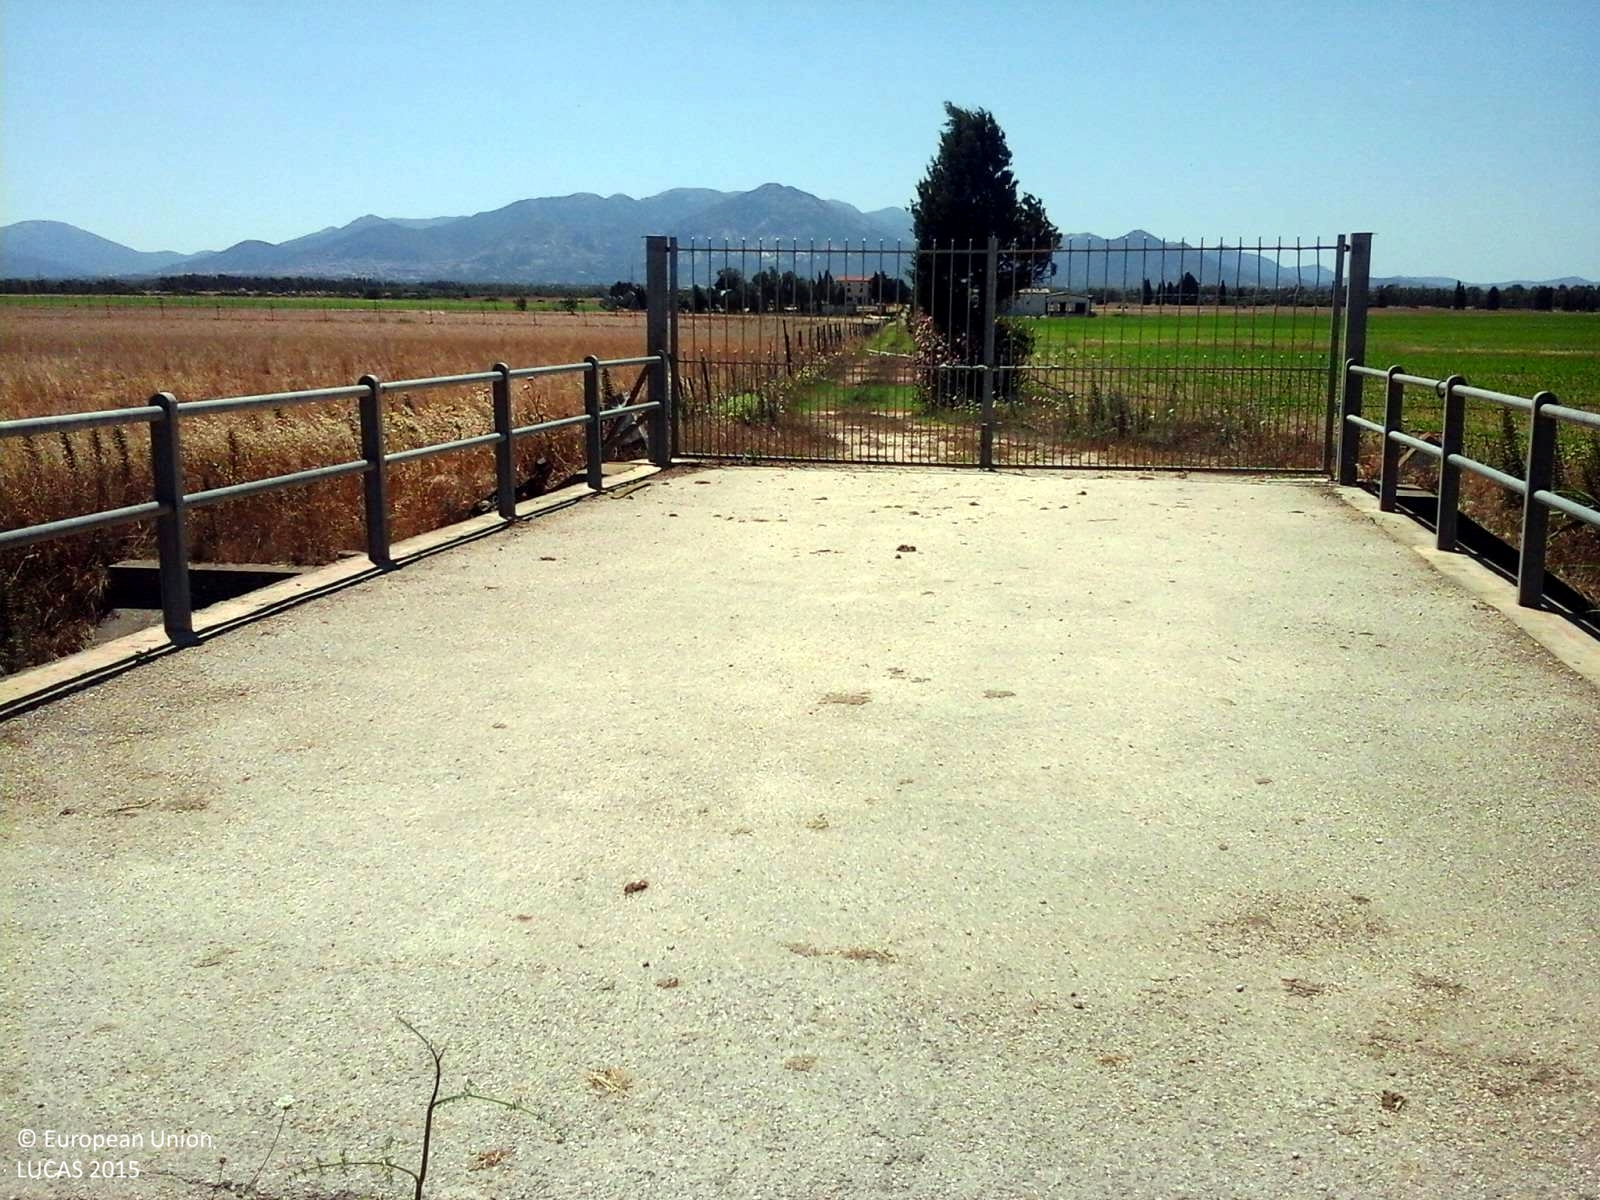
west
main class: Cropland
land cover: Maize
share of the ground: > 75 %
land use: Agriculture (excluding fallow land and kitchen gardens)
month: June
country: IT
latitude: 39.5175
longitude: 8.8090
